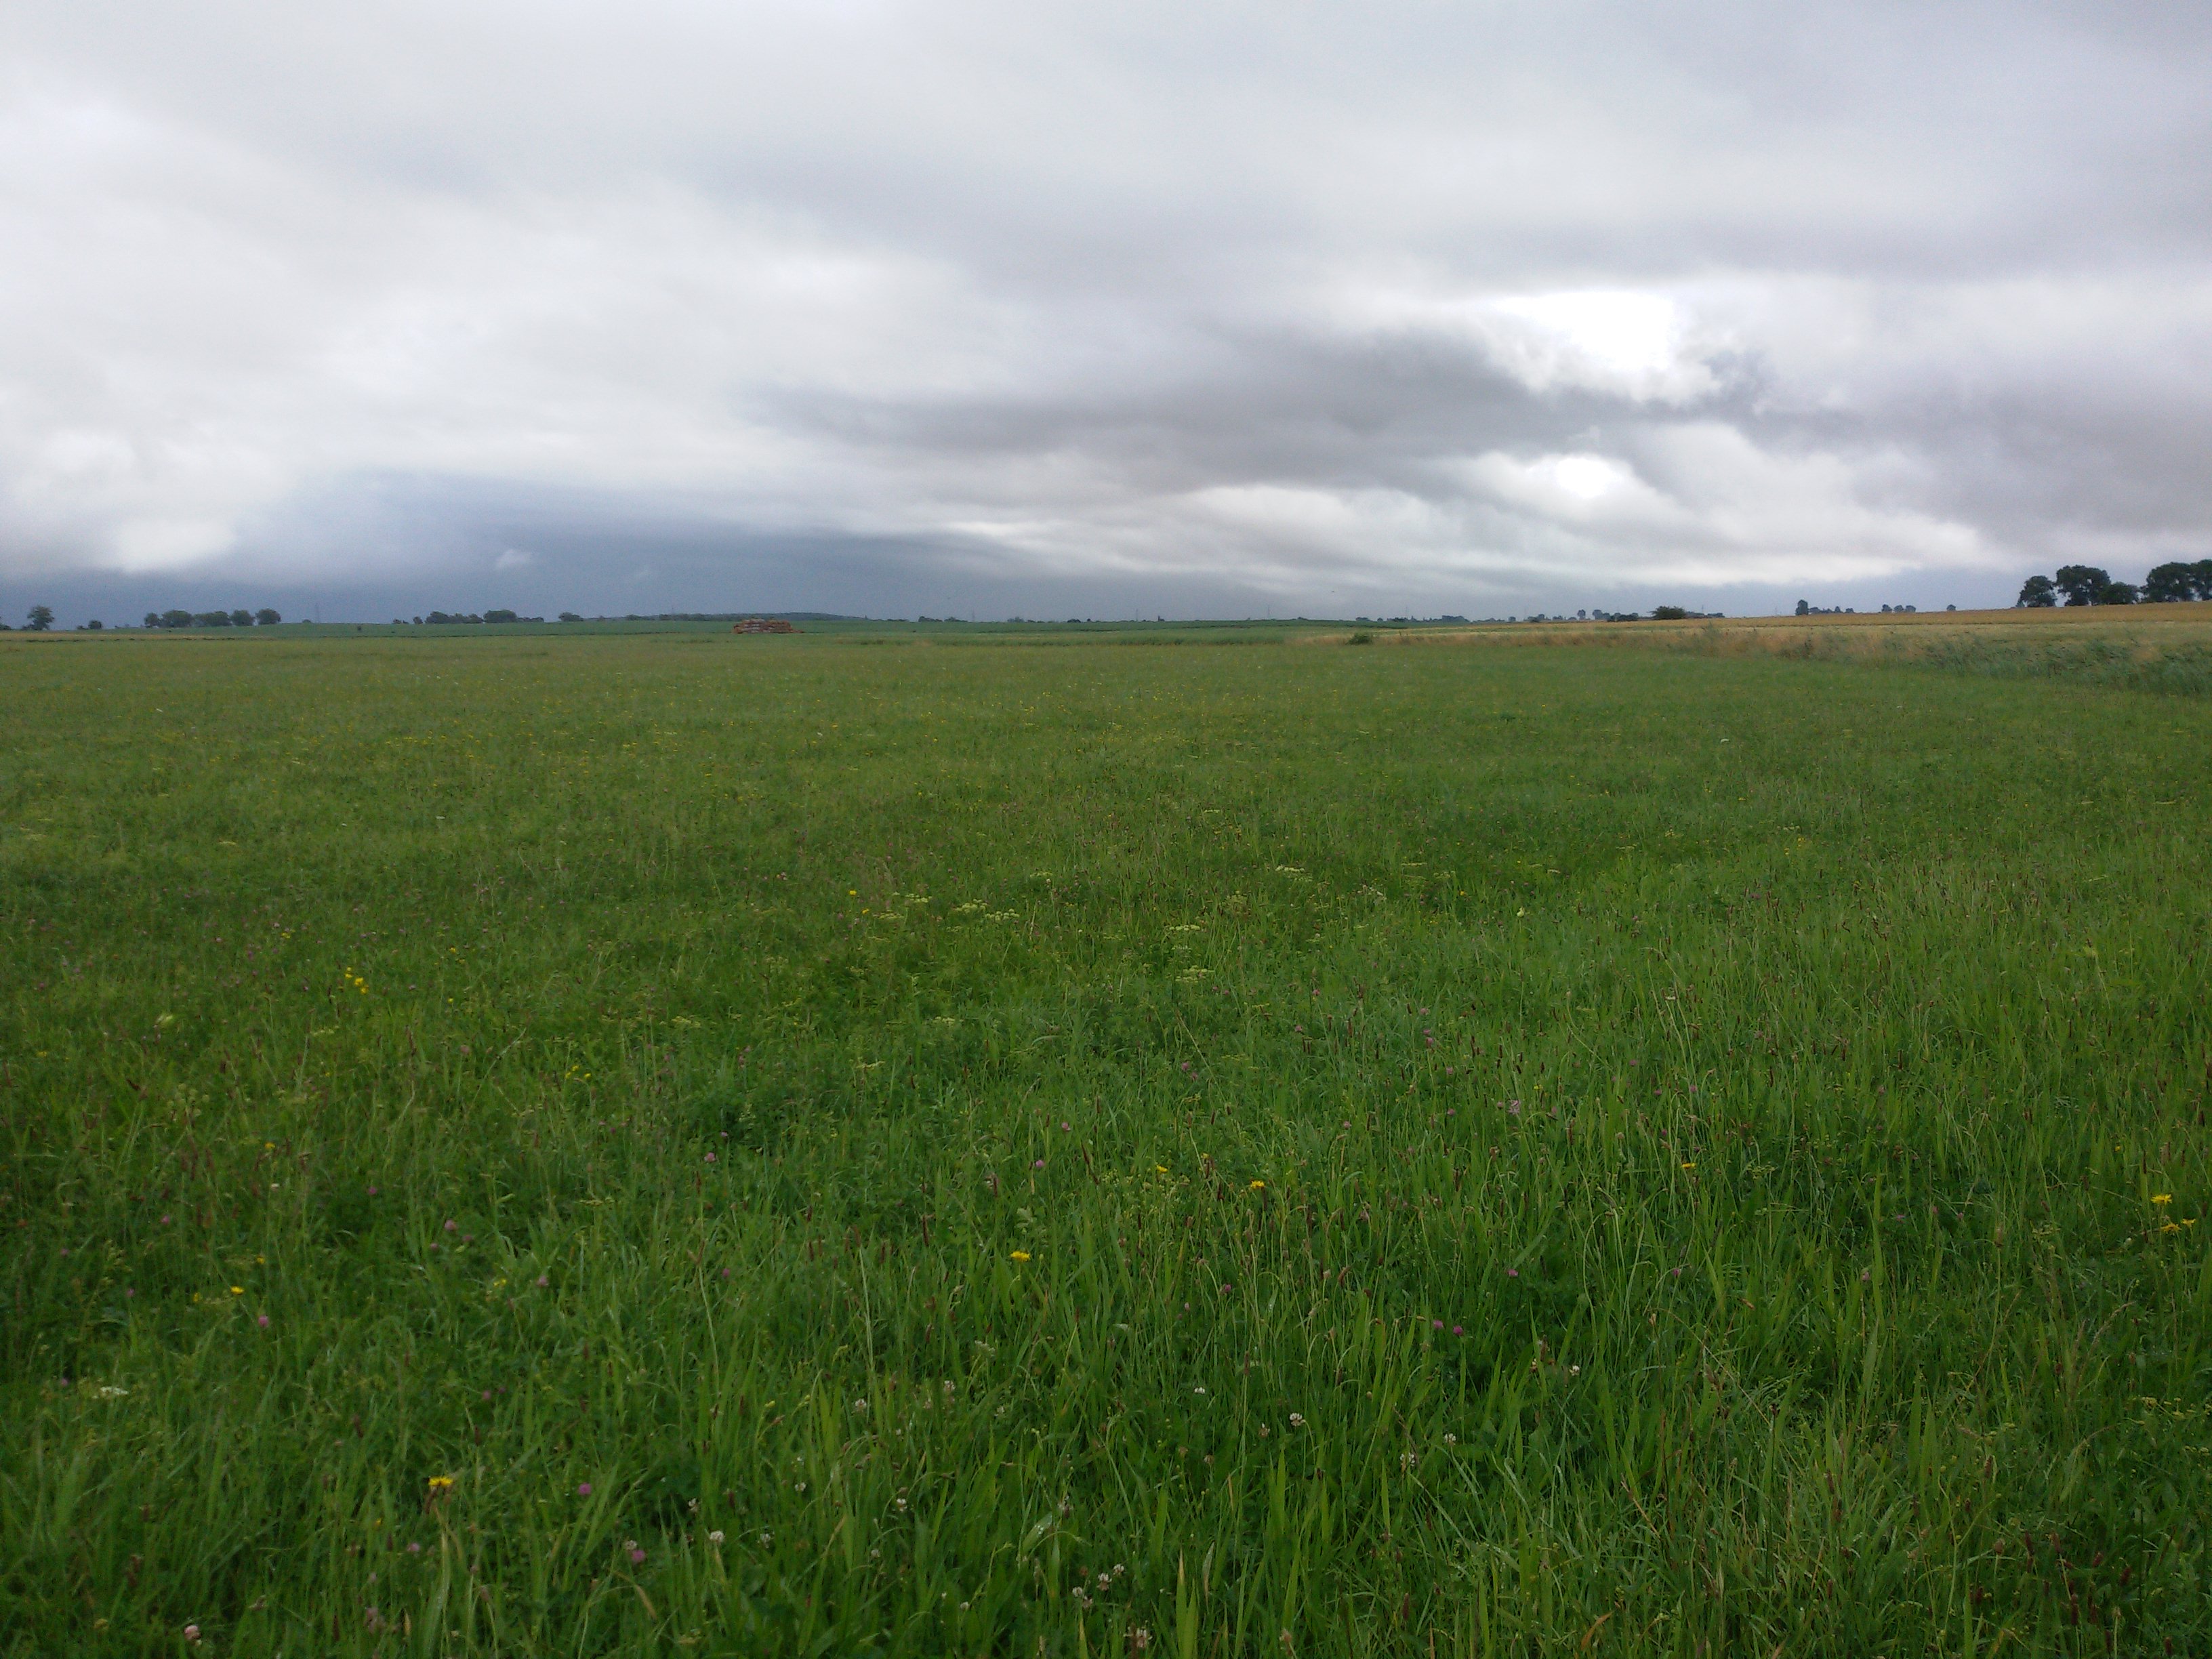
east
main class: Cropland
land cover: Barley
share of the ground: > 75 %
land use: Agriculture (excluding fallow land and kitchen gardens)
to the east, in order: Barley; Dry pulses; Triticale
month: July
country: PL
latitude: 52.9113
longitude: 17.5816
